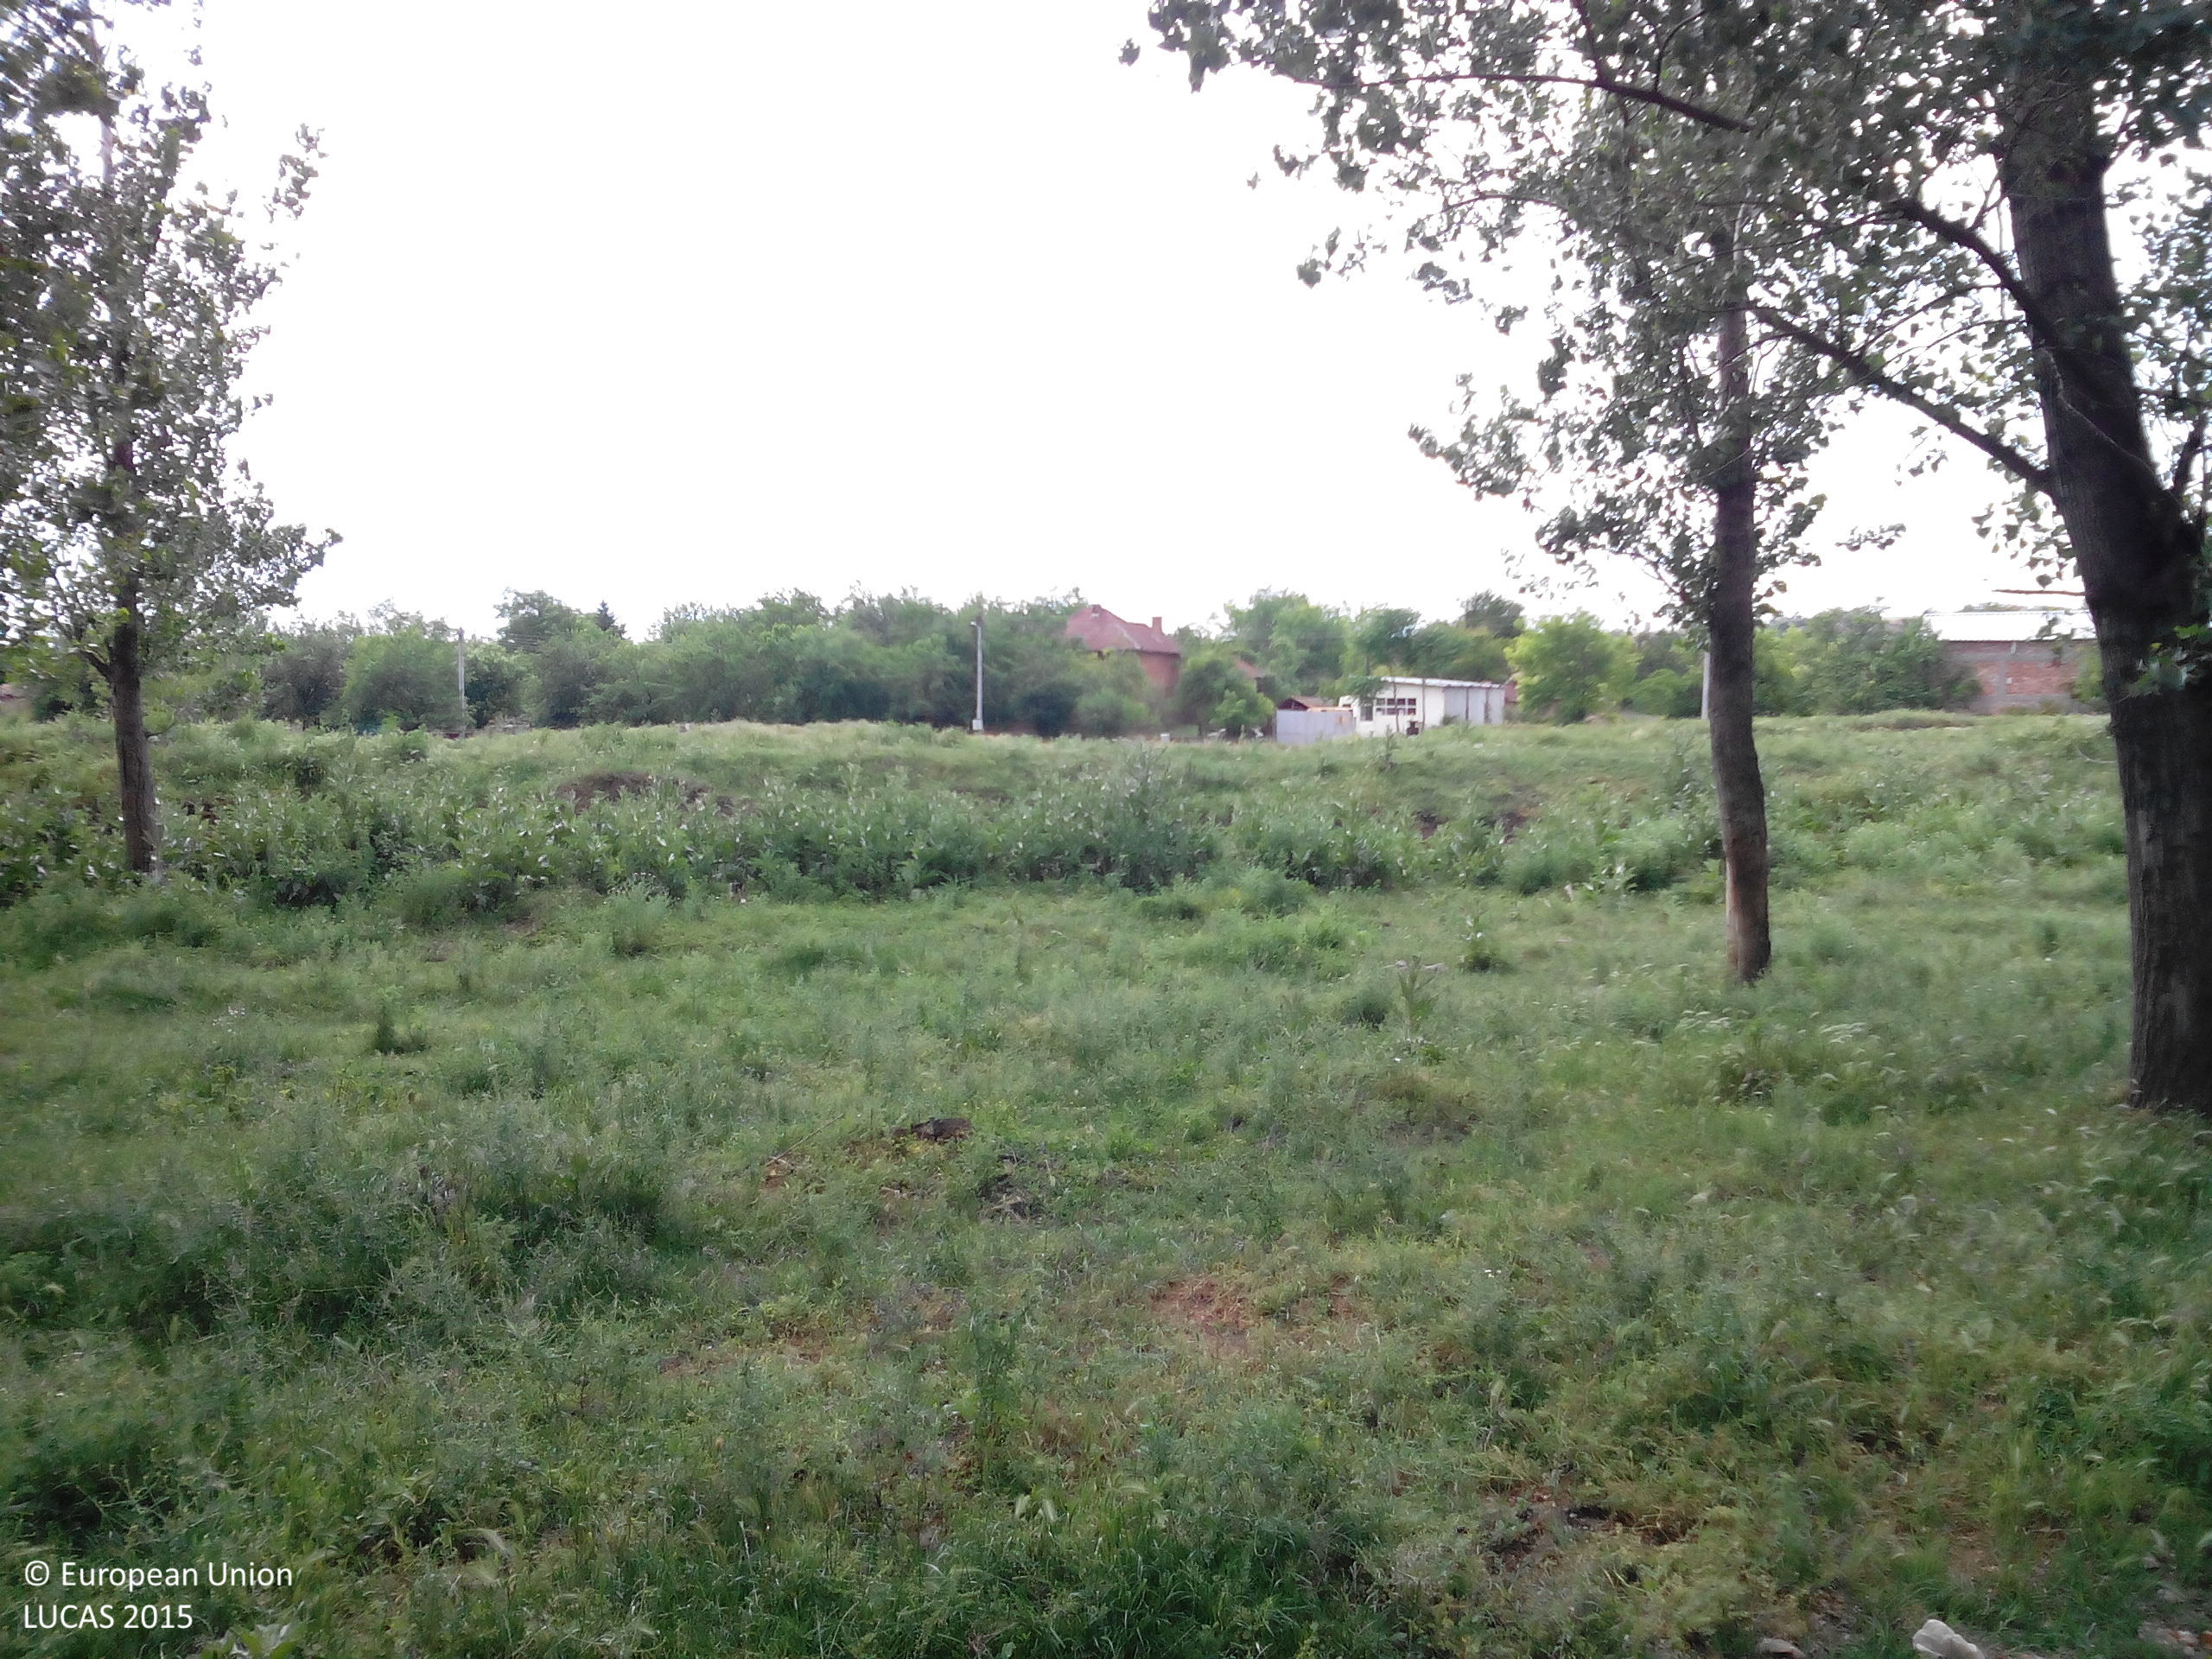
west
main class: Woodland
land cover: Broadleaved woodland
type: mesophytic deciduous forest
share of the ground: 50 - 75 %
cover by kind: broadleaved forest trees 70 %, herbaceous plants 30 %
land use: Forestry
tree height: > 5 m
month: May
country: BG
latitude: 43.5117
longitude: 24.2202
